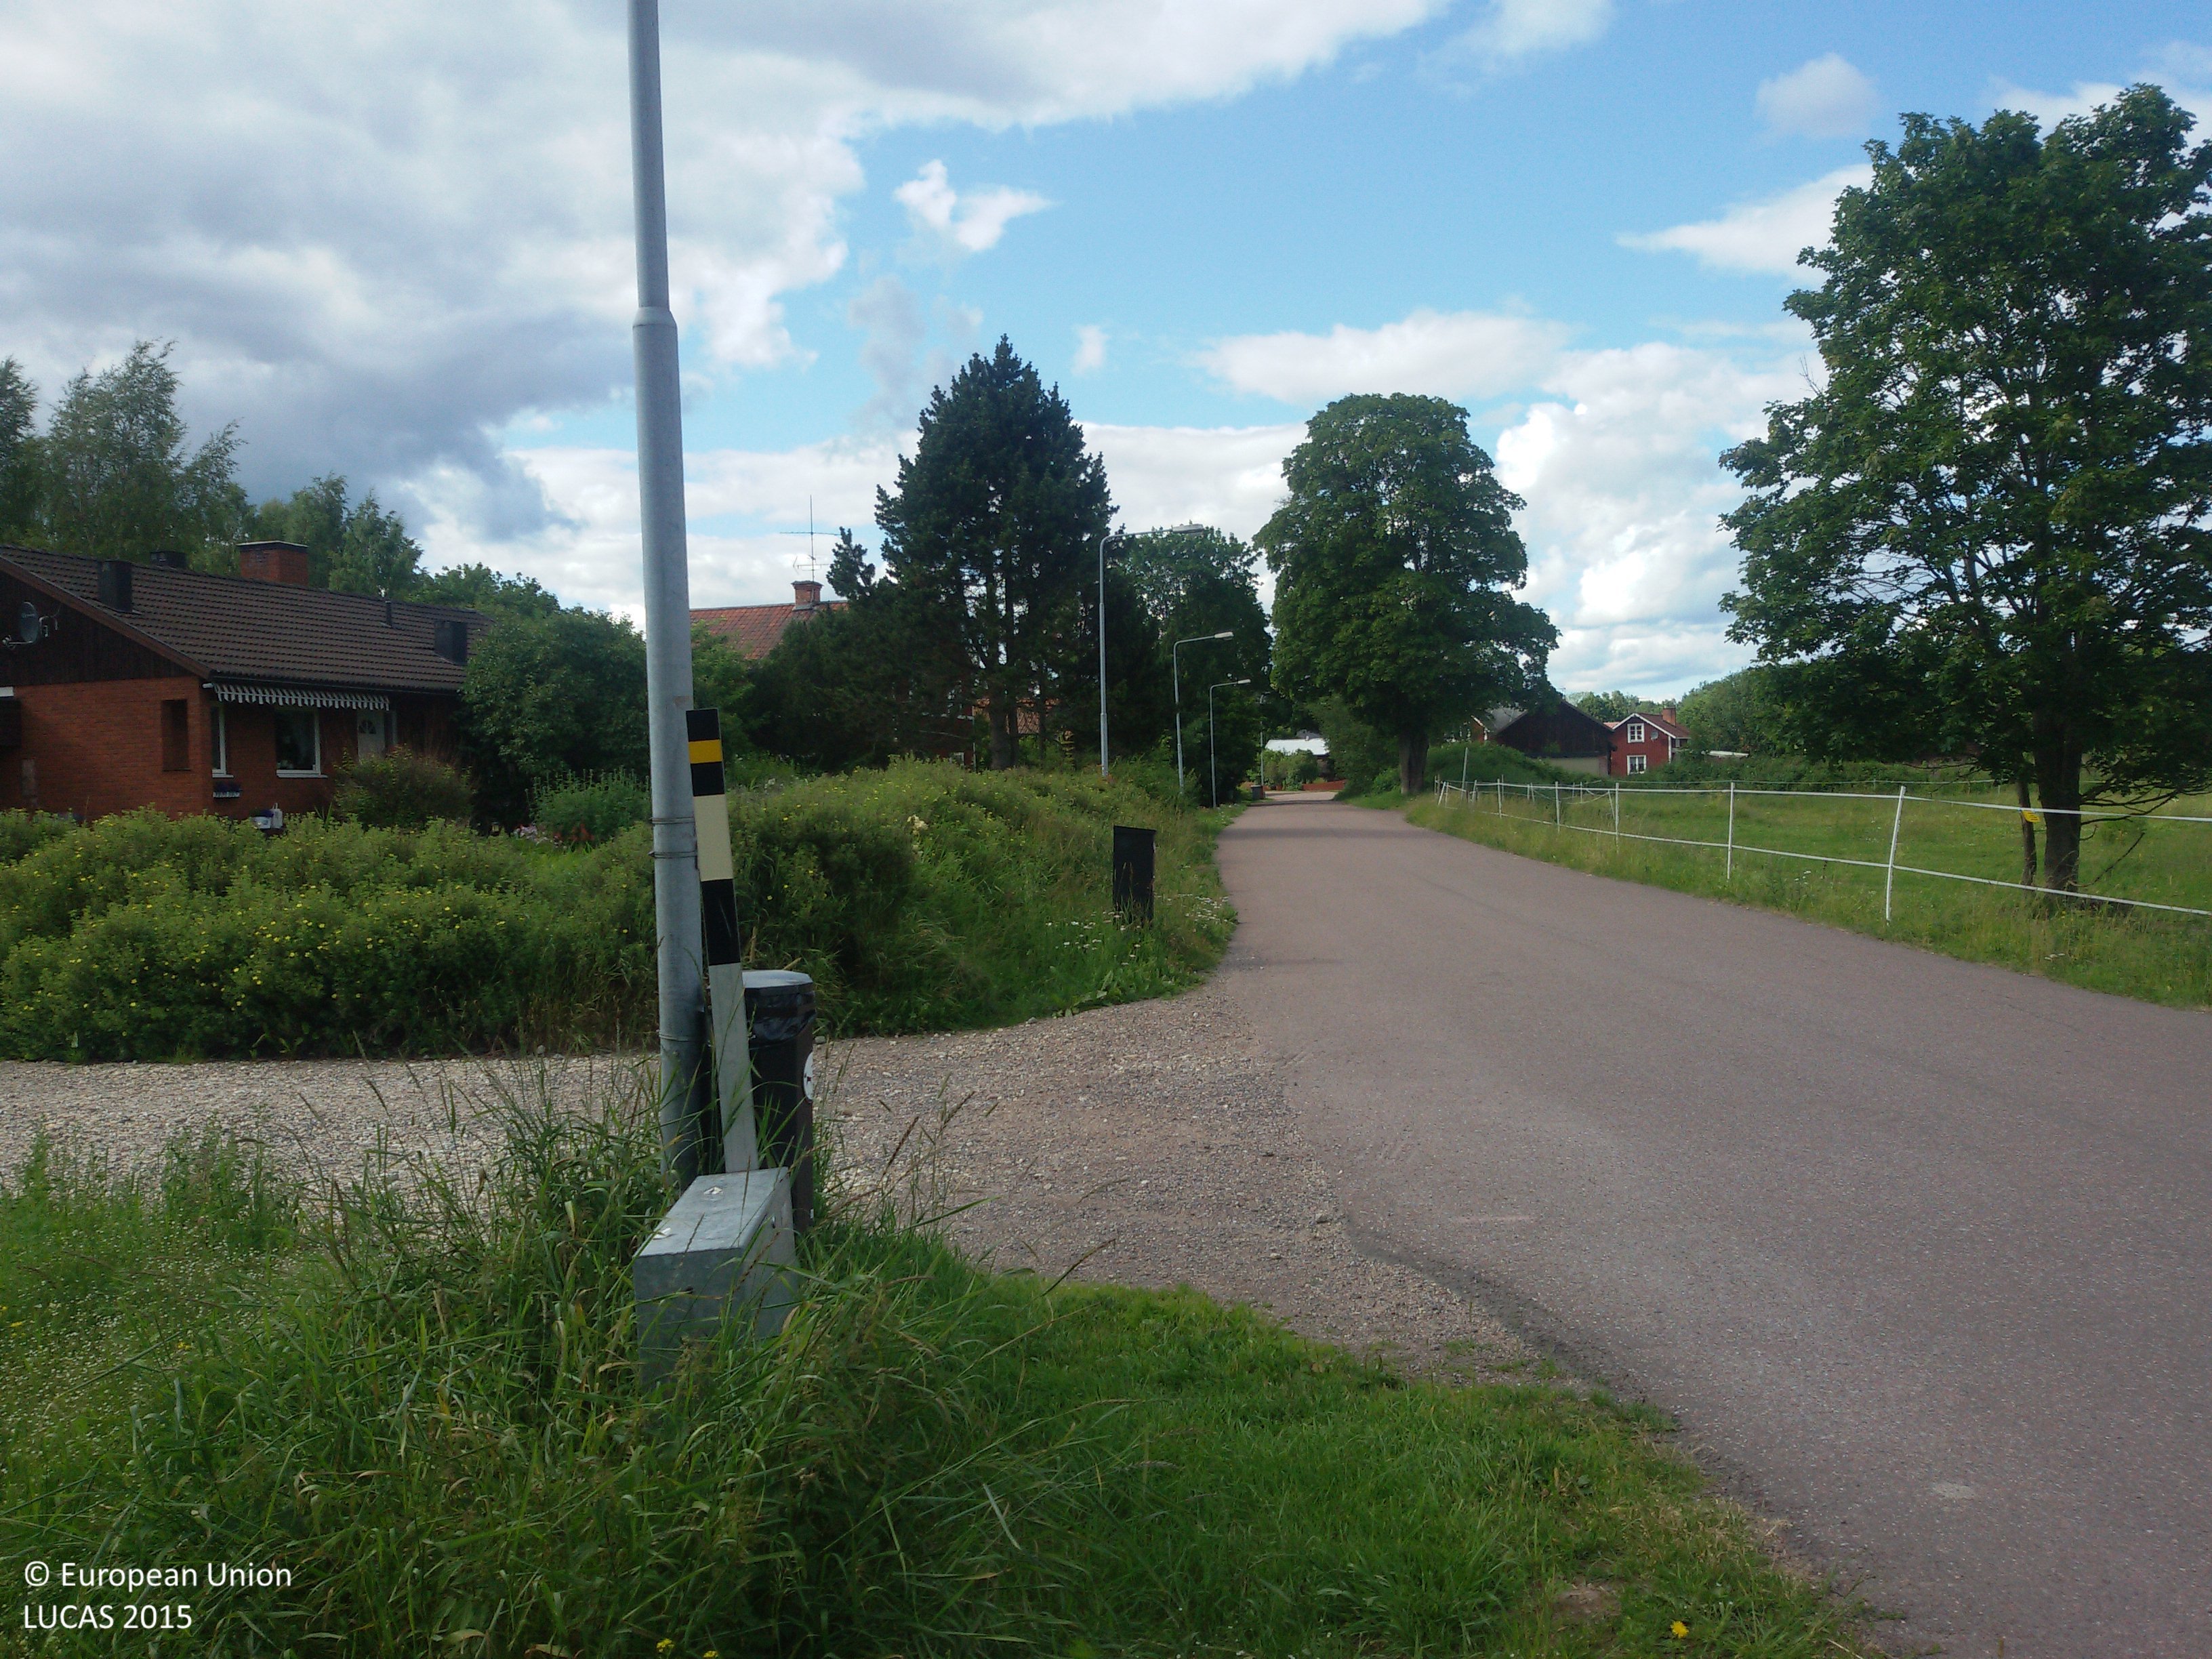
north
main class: Grassland
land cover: Grassland without tree/shrub cover
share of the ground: > 75 %
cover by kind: herbaceous plants 100 %
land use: Road transport
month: July
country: SE
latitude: 60.4748
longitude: 15.3906
